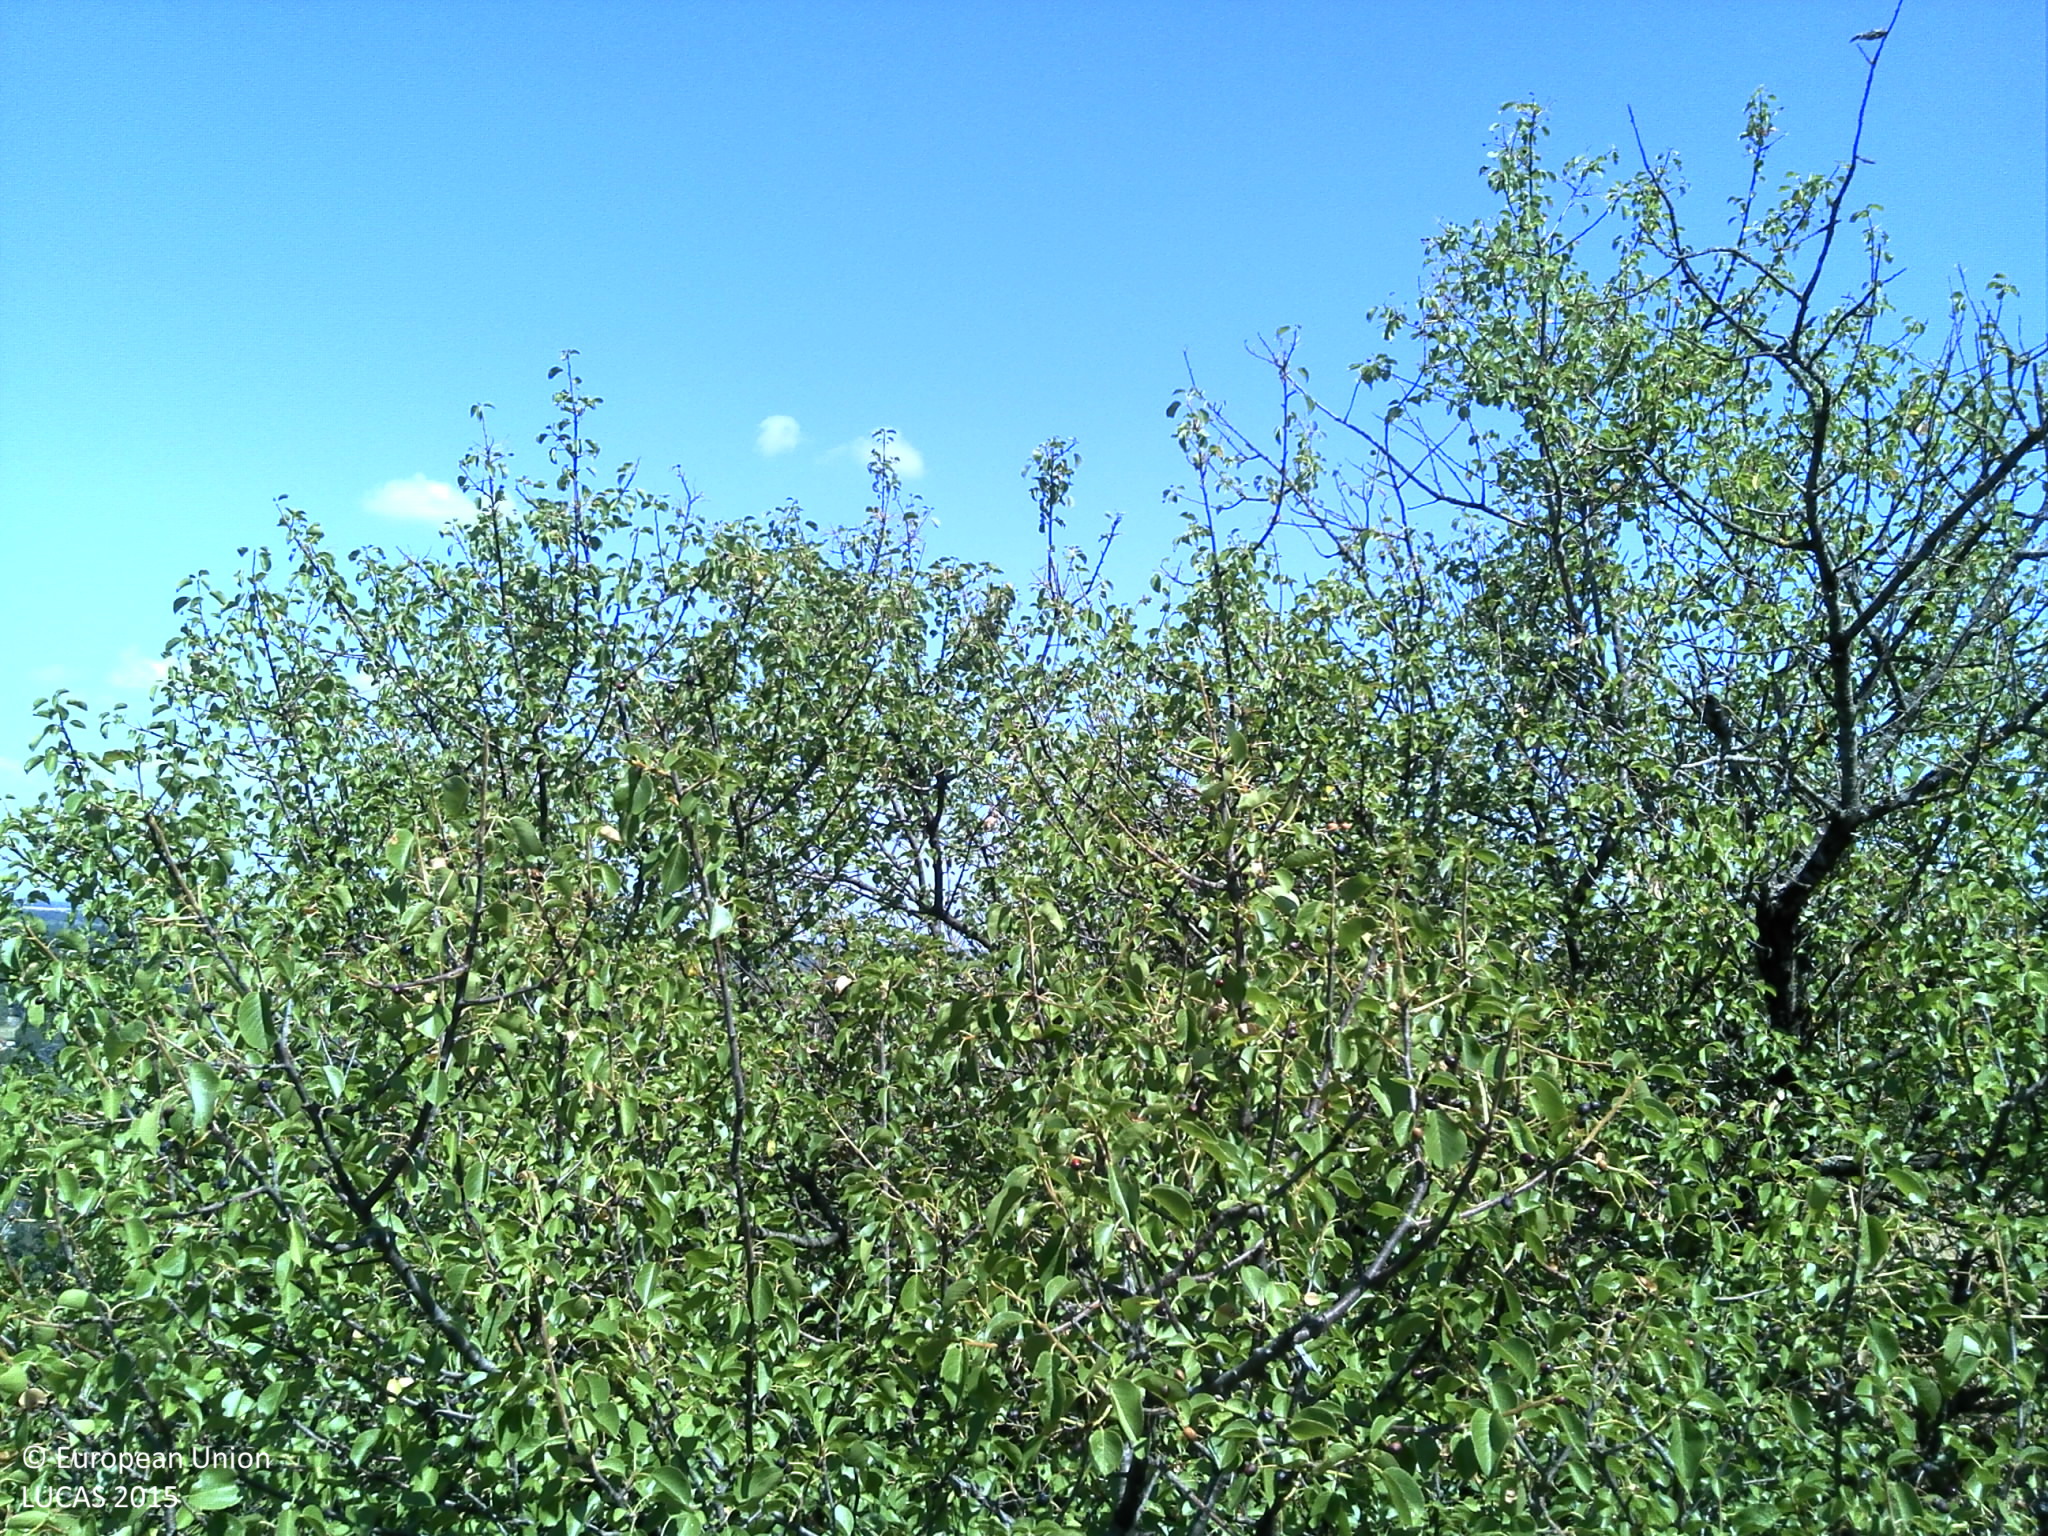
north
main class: Woodland
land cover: Broadleaved woodland
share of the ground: > 75 %
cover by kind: herbaceous plants 50 %, broadleaved forest trees 30 %, shrubs 20 %
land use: Semi-natural and natural areas not in use
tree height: < 5 m
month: July
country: FR
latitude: 45.9869
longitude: 4.0505
